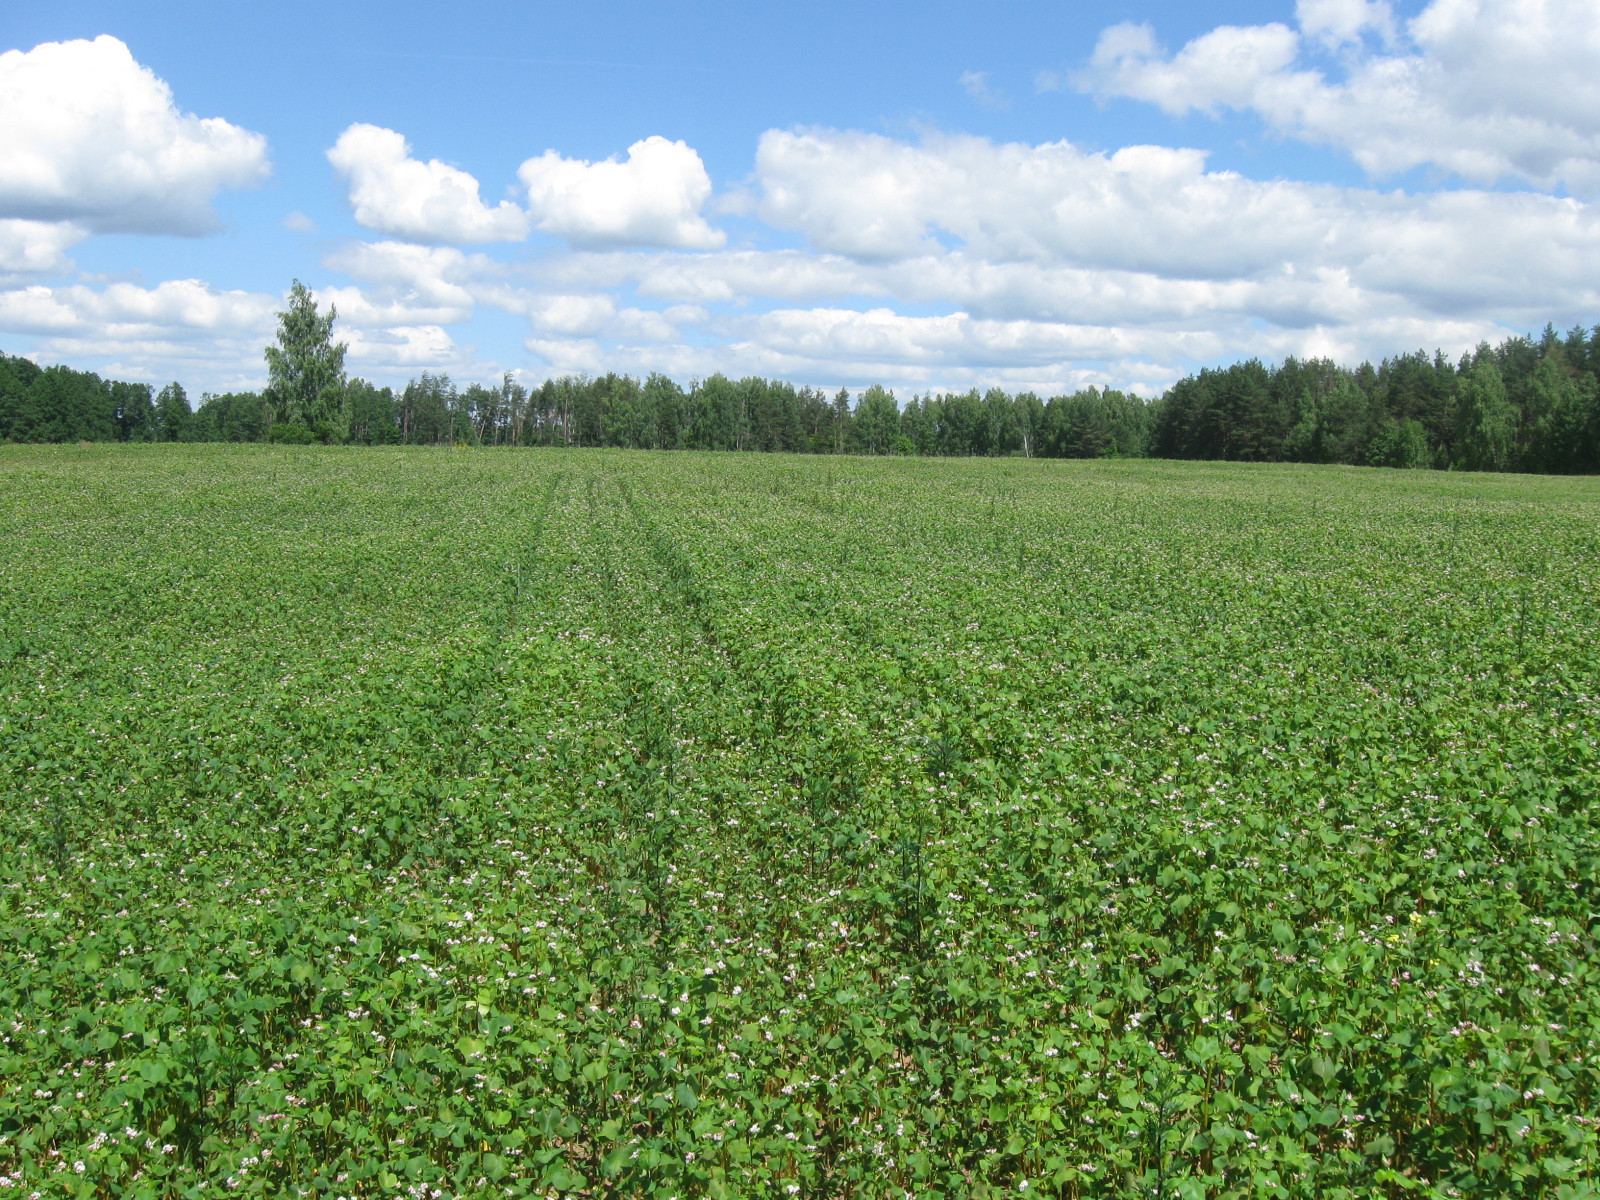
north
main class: Cropland
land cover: Other cereals
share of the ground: > 75 %
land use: Agriculture (excluding fallow land and kitchen gardens)
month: July
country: LT
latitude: 54.3385
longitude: 24.6099
